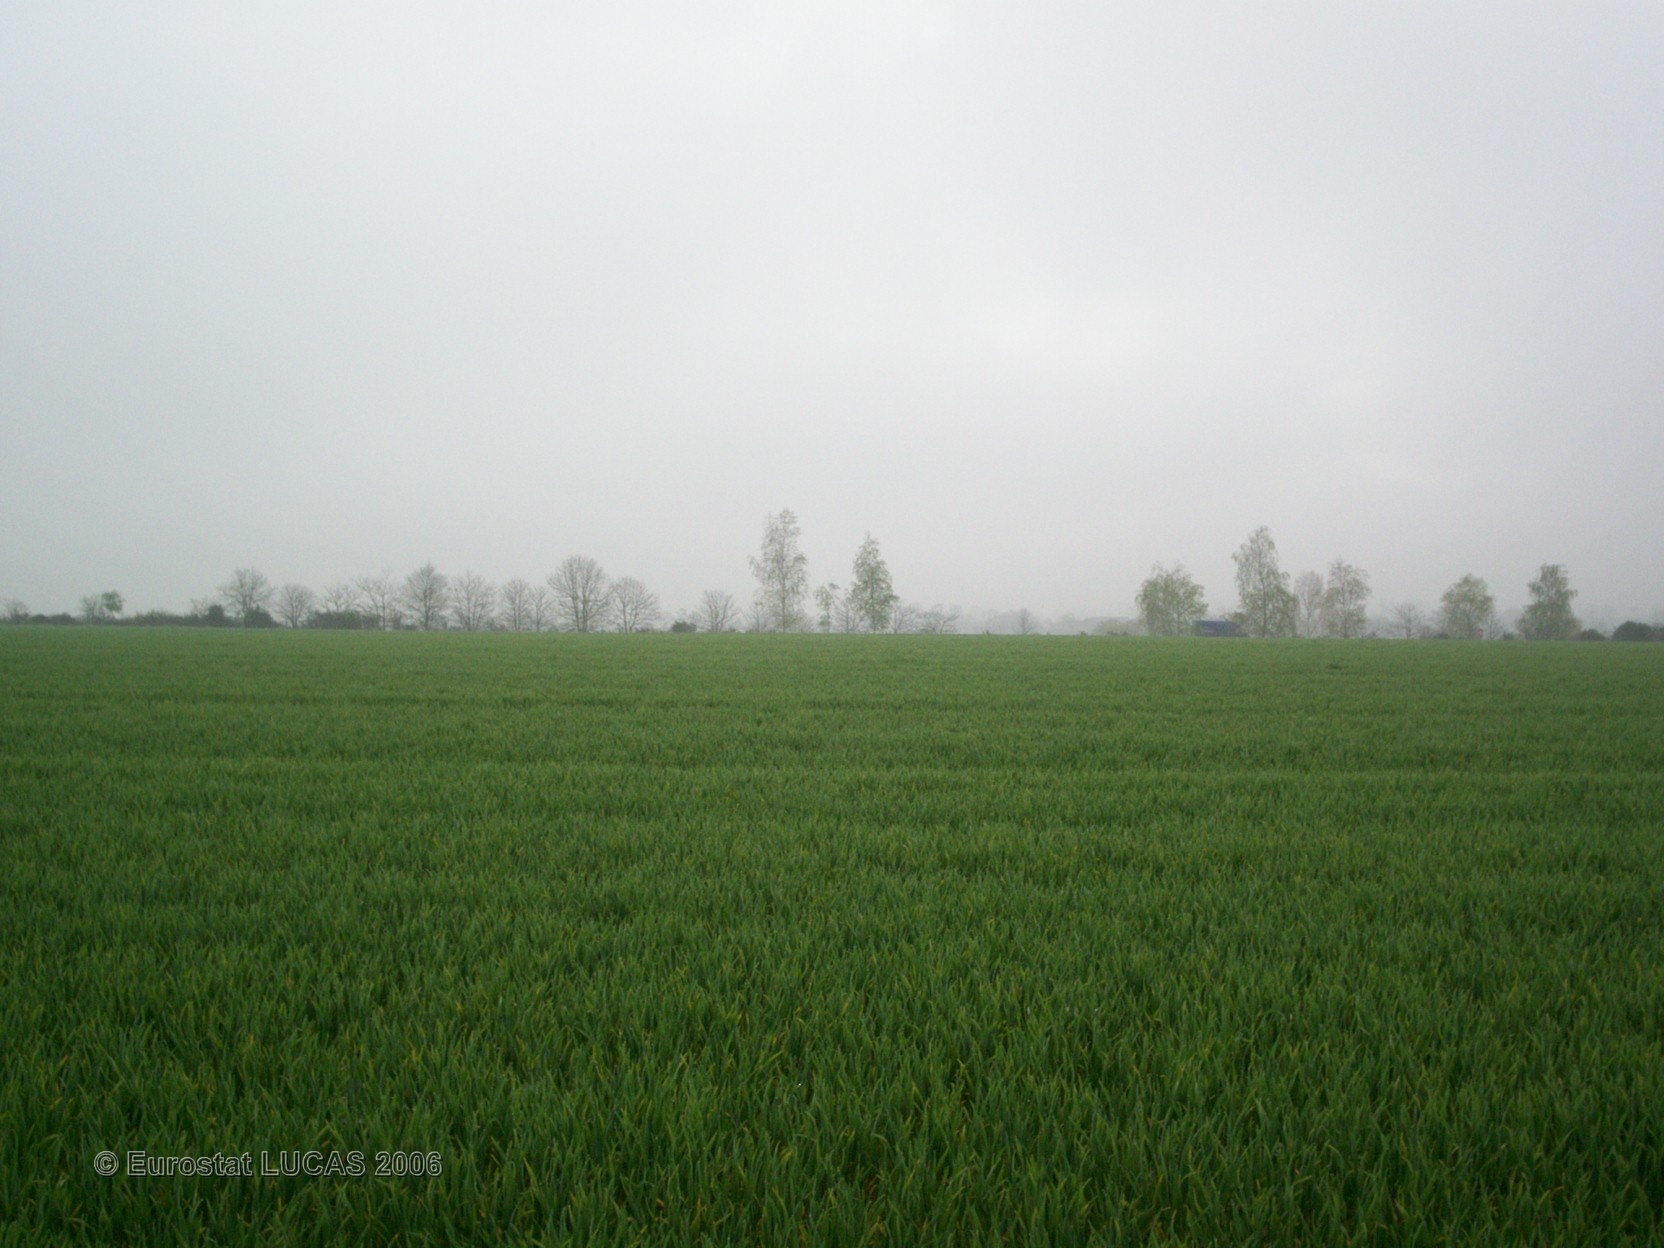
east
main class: Cropland
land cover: Common wheat
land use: Agriculture (excluding fallow land and kitchen gardens)
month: April
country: FR
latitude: 48.2316
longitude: -0.6579
